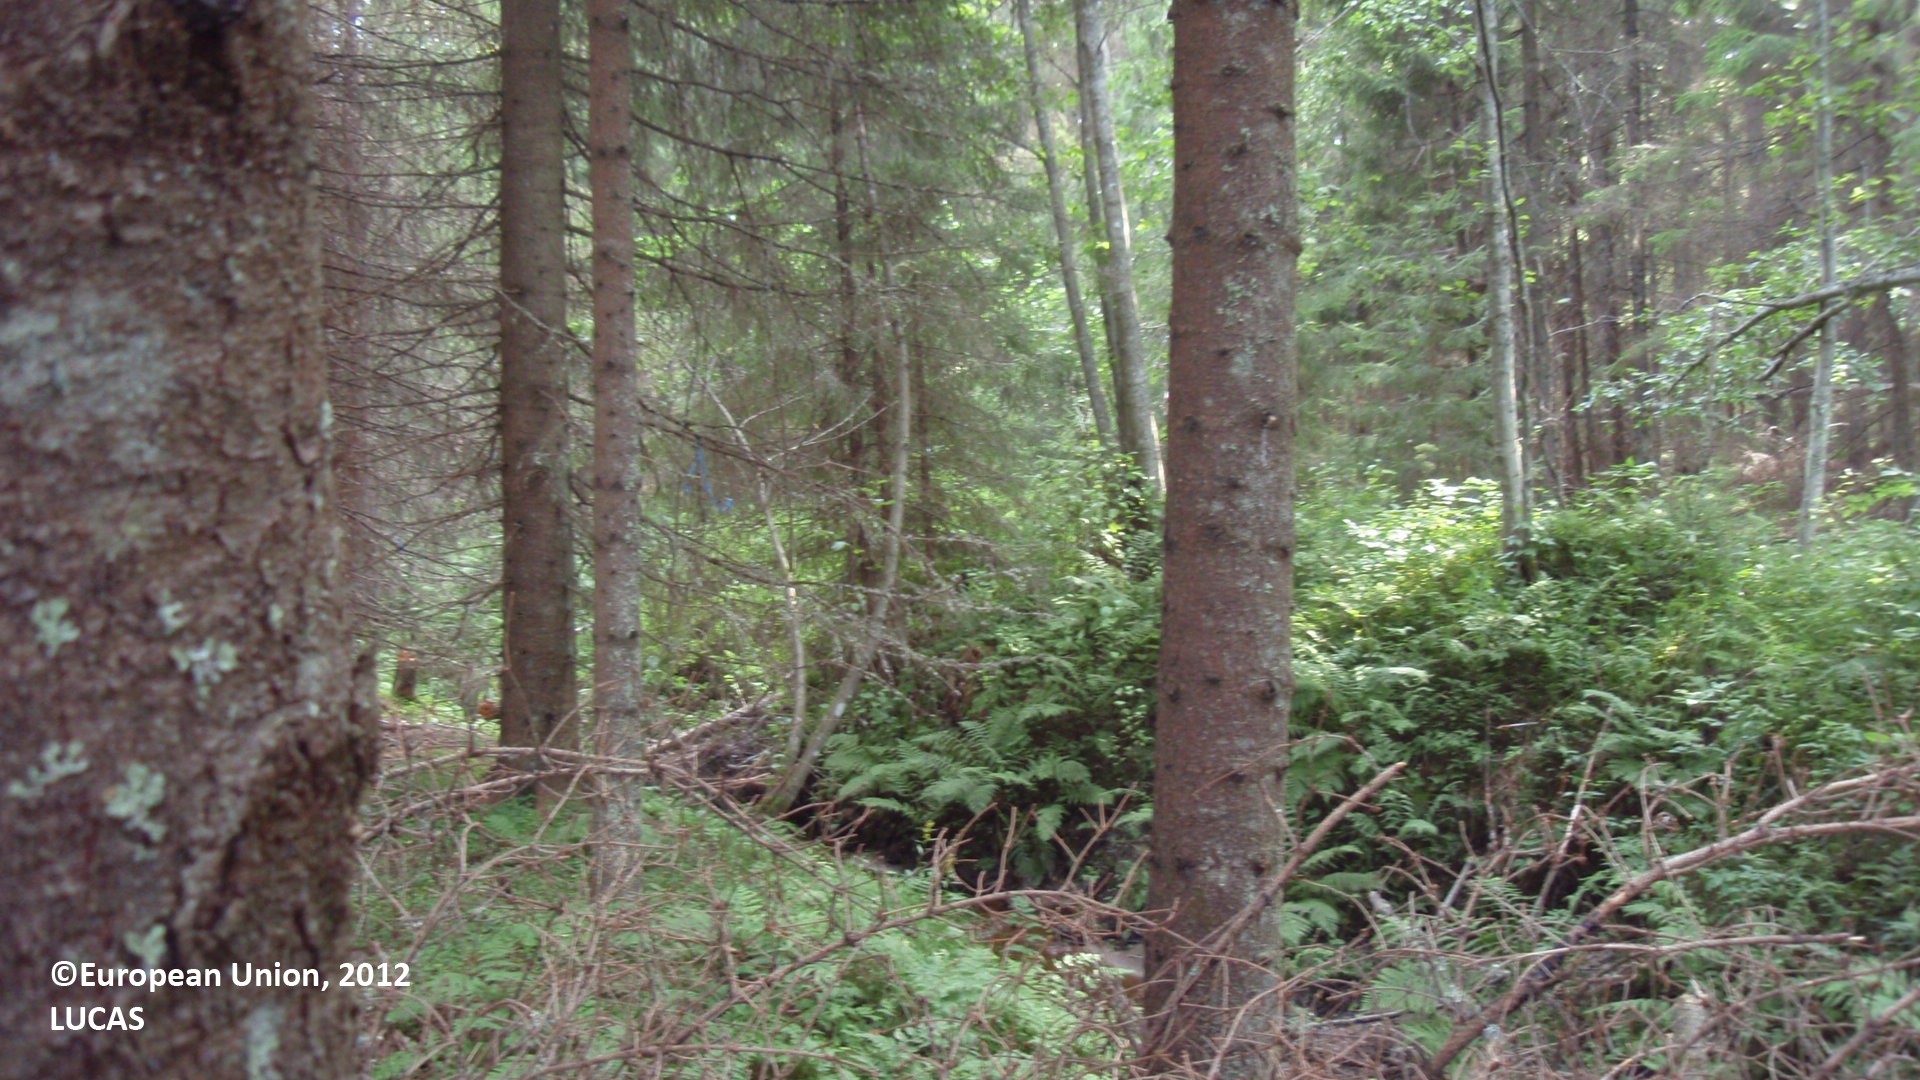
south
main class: Woodland
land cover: Spruce dominated coniferous woodland
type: boreal forest
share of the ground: 50 - 75 %
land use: Forestry
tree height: > 5 m
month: August
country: FI
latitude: 60.7726
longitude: 27.2320
